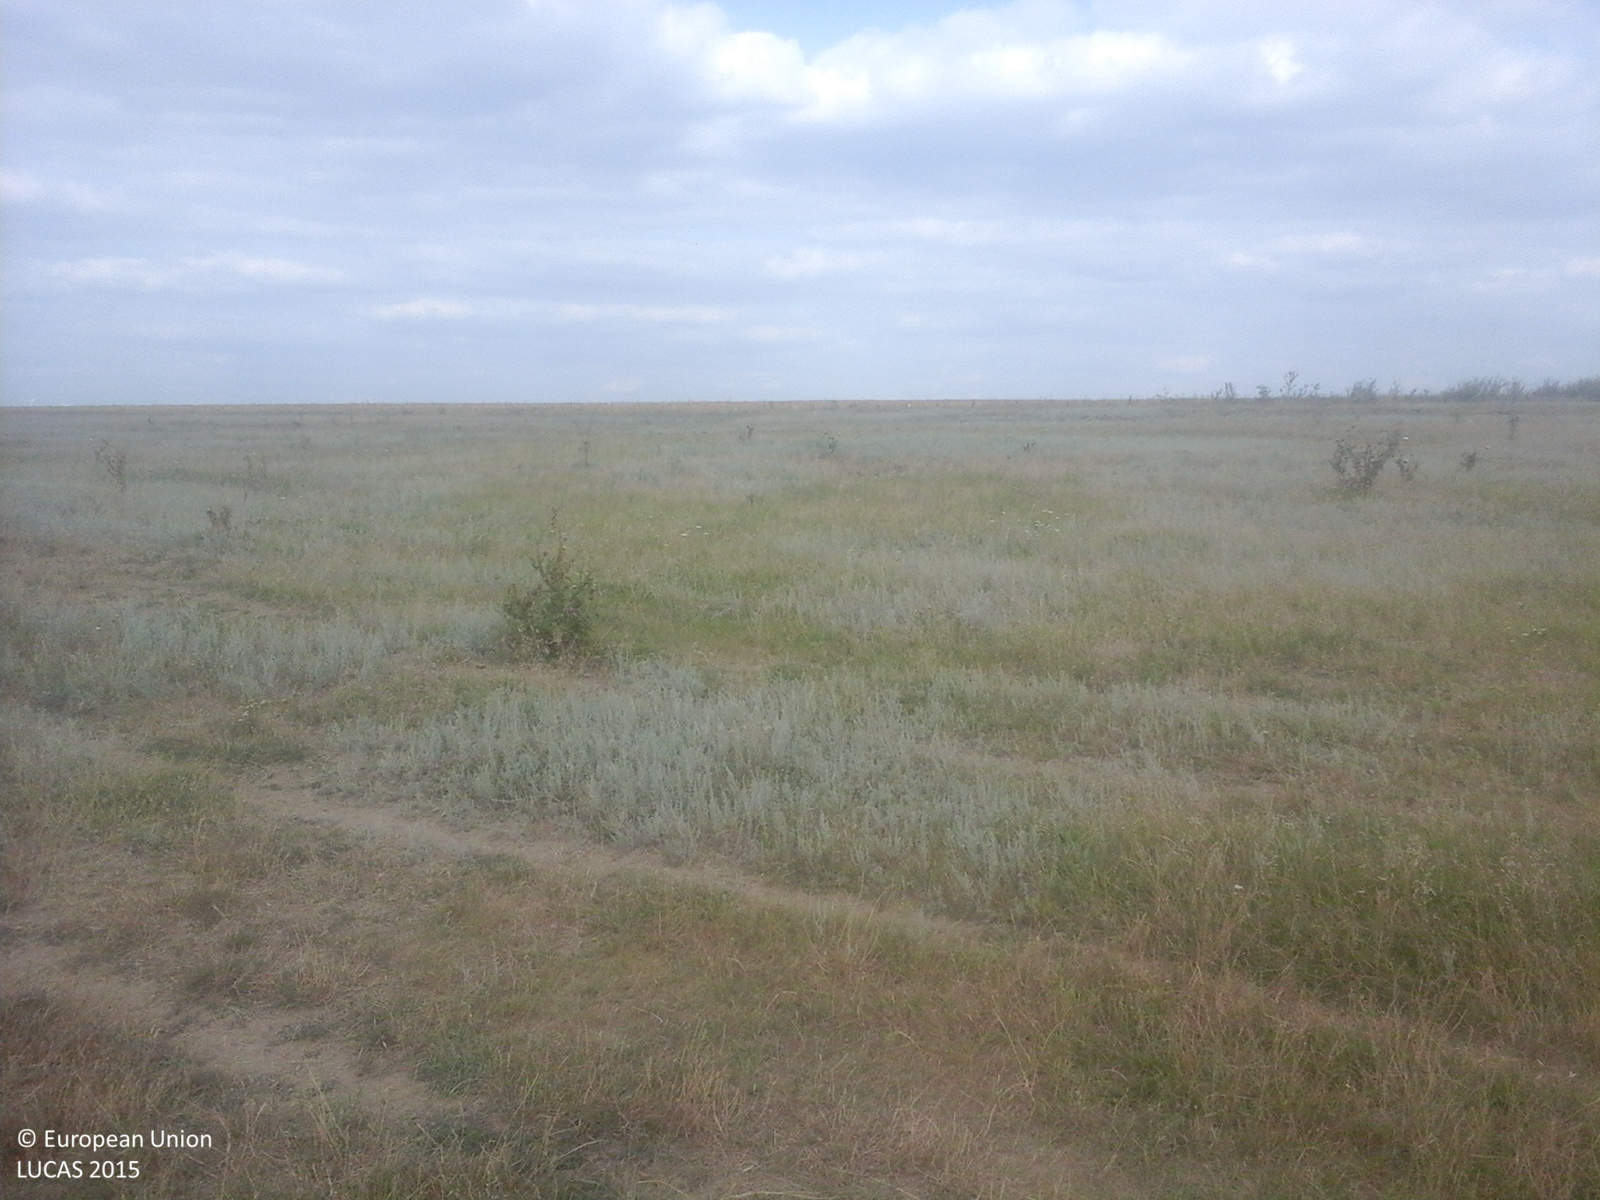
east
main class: Grassland
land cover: Grassland without tree/shrub cover
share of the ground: > 75 %
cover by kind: herbaceous plants 100 %
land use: Agriculture (excluding fallow land and kitchen gardens)
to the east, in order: Grassland without tree/shrub cover; Tracks; Durum wheat
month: August
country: RO
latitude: 44.7117
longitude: 28.2307
